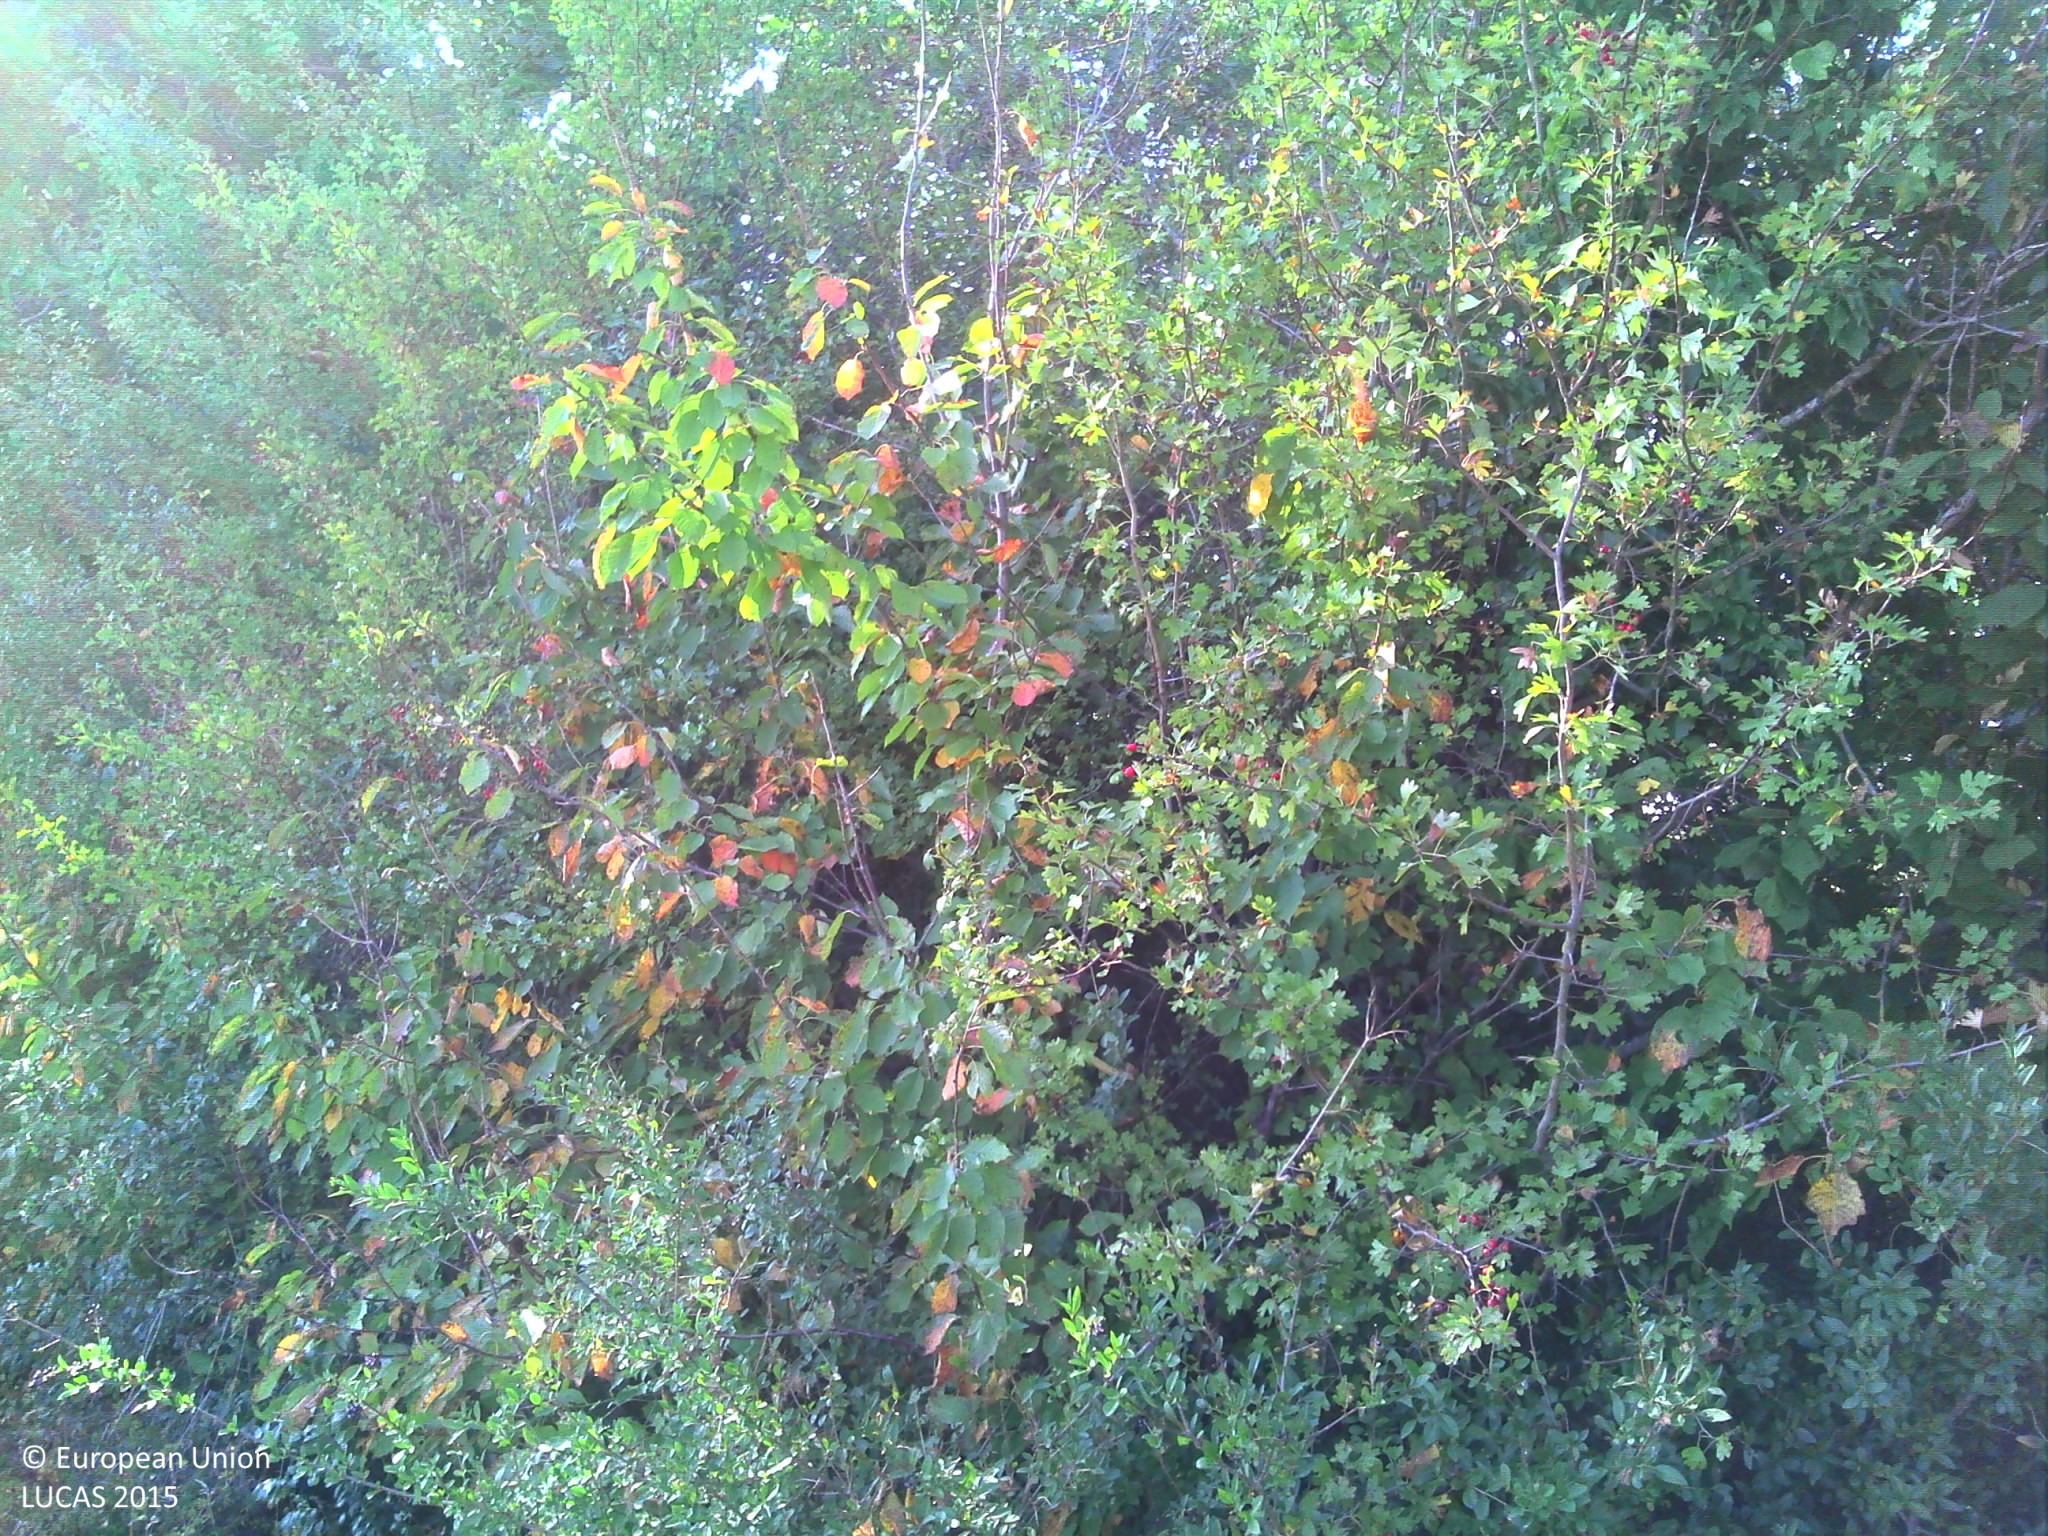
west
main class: Woodland
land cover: Broadleaved woodland
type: mesophytic deciduous forest
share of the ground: > 75 %
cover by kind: broadleaved forest trees 85 %, shrubs 10 %, coniferous forest trees 5 %
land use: Semi-natural and natural areas not in use
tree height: > 5 m
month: September
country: FR
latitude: 45.3134
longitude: 4.9919
